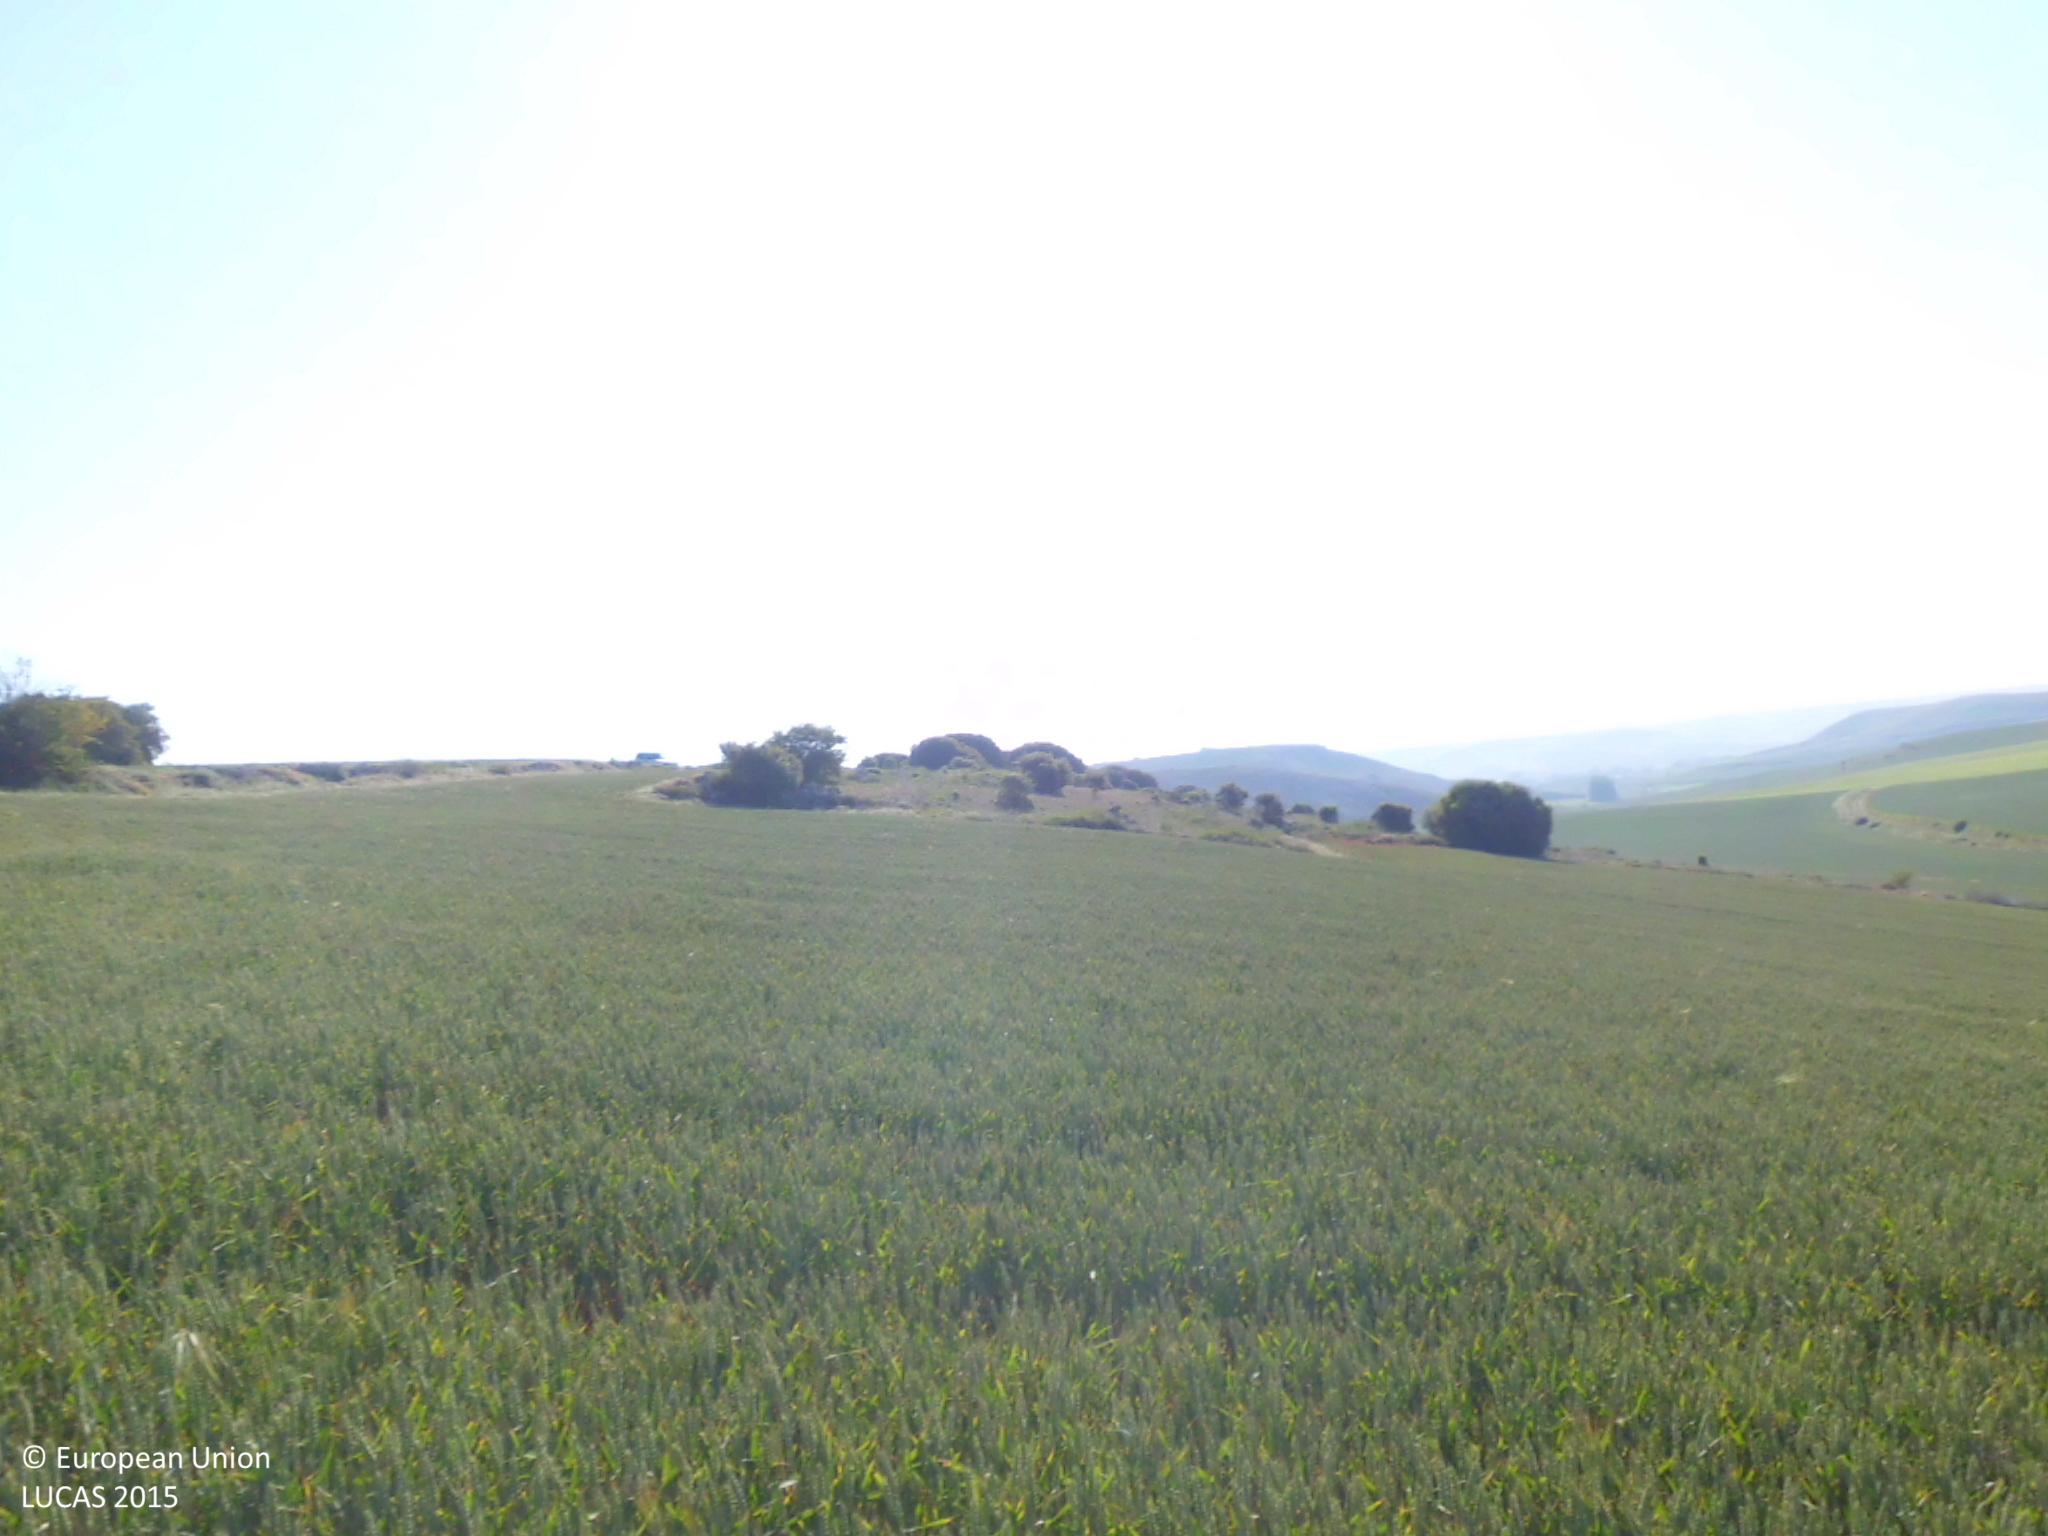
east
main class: Cropland
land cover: Common wheat
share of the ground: > 75 %
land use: Agriculture (excluding fallow land and kitchen gardens)
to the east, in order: Common wheat; Shrubland without tree cover
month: June
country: ES
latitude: 42.3404
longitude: -3.9622
